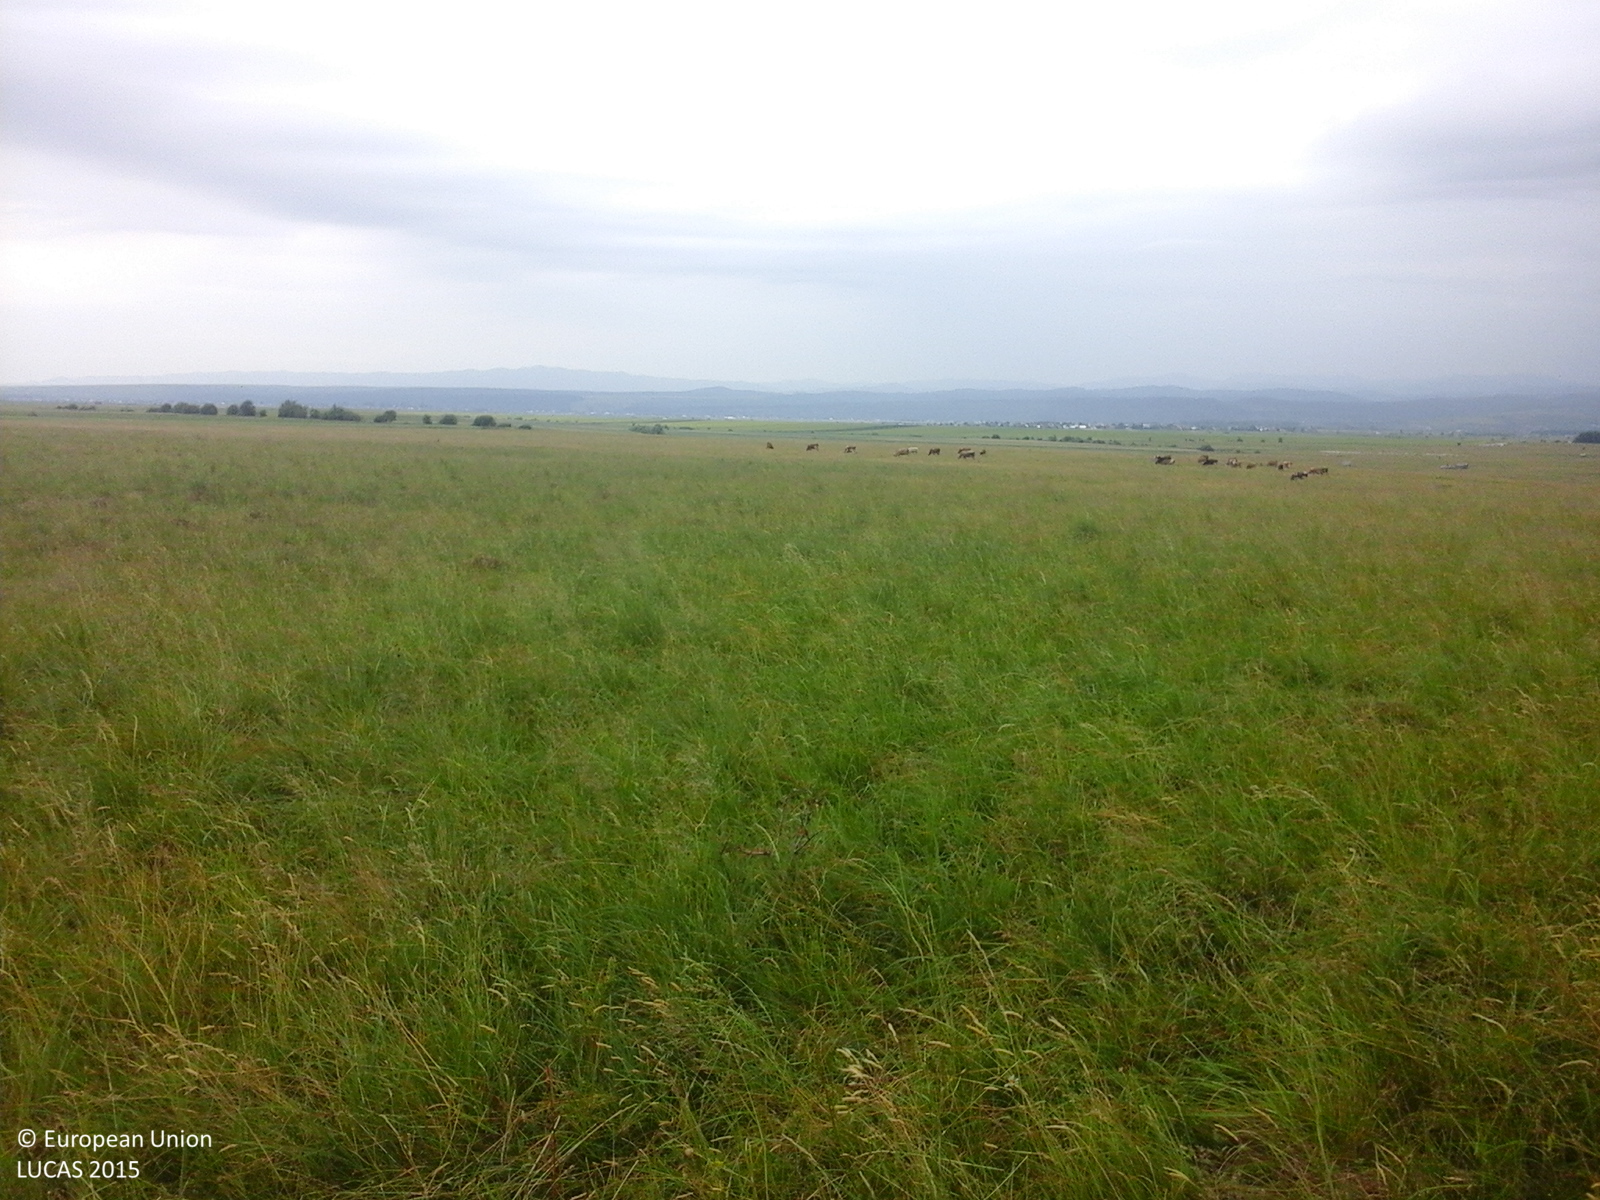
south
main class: Grassland
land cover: Grassland without tree/shrub cover
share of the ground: > 75 %
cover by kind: herbaceous plants 100 %
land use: Agriculture (excluding fallow land and kitchen gardens)
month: June
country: RO
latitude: 47.4907
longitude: 26.2075
